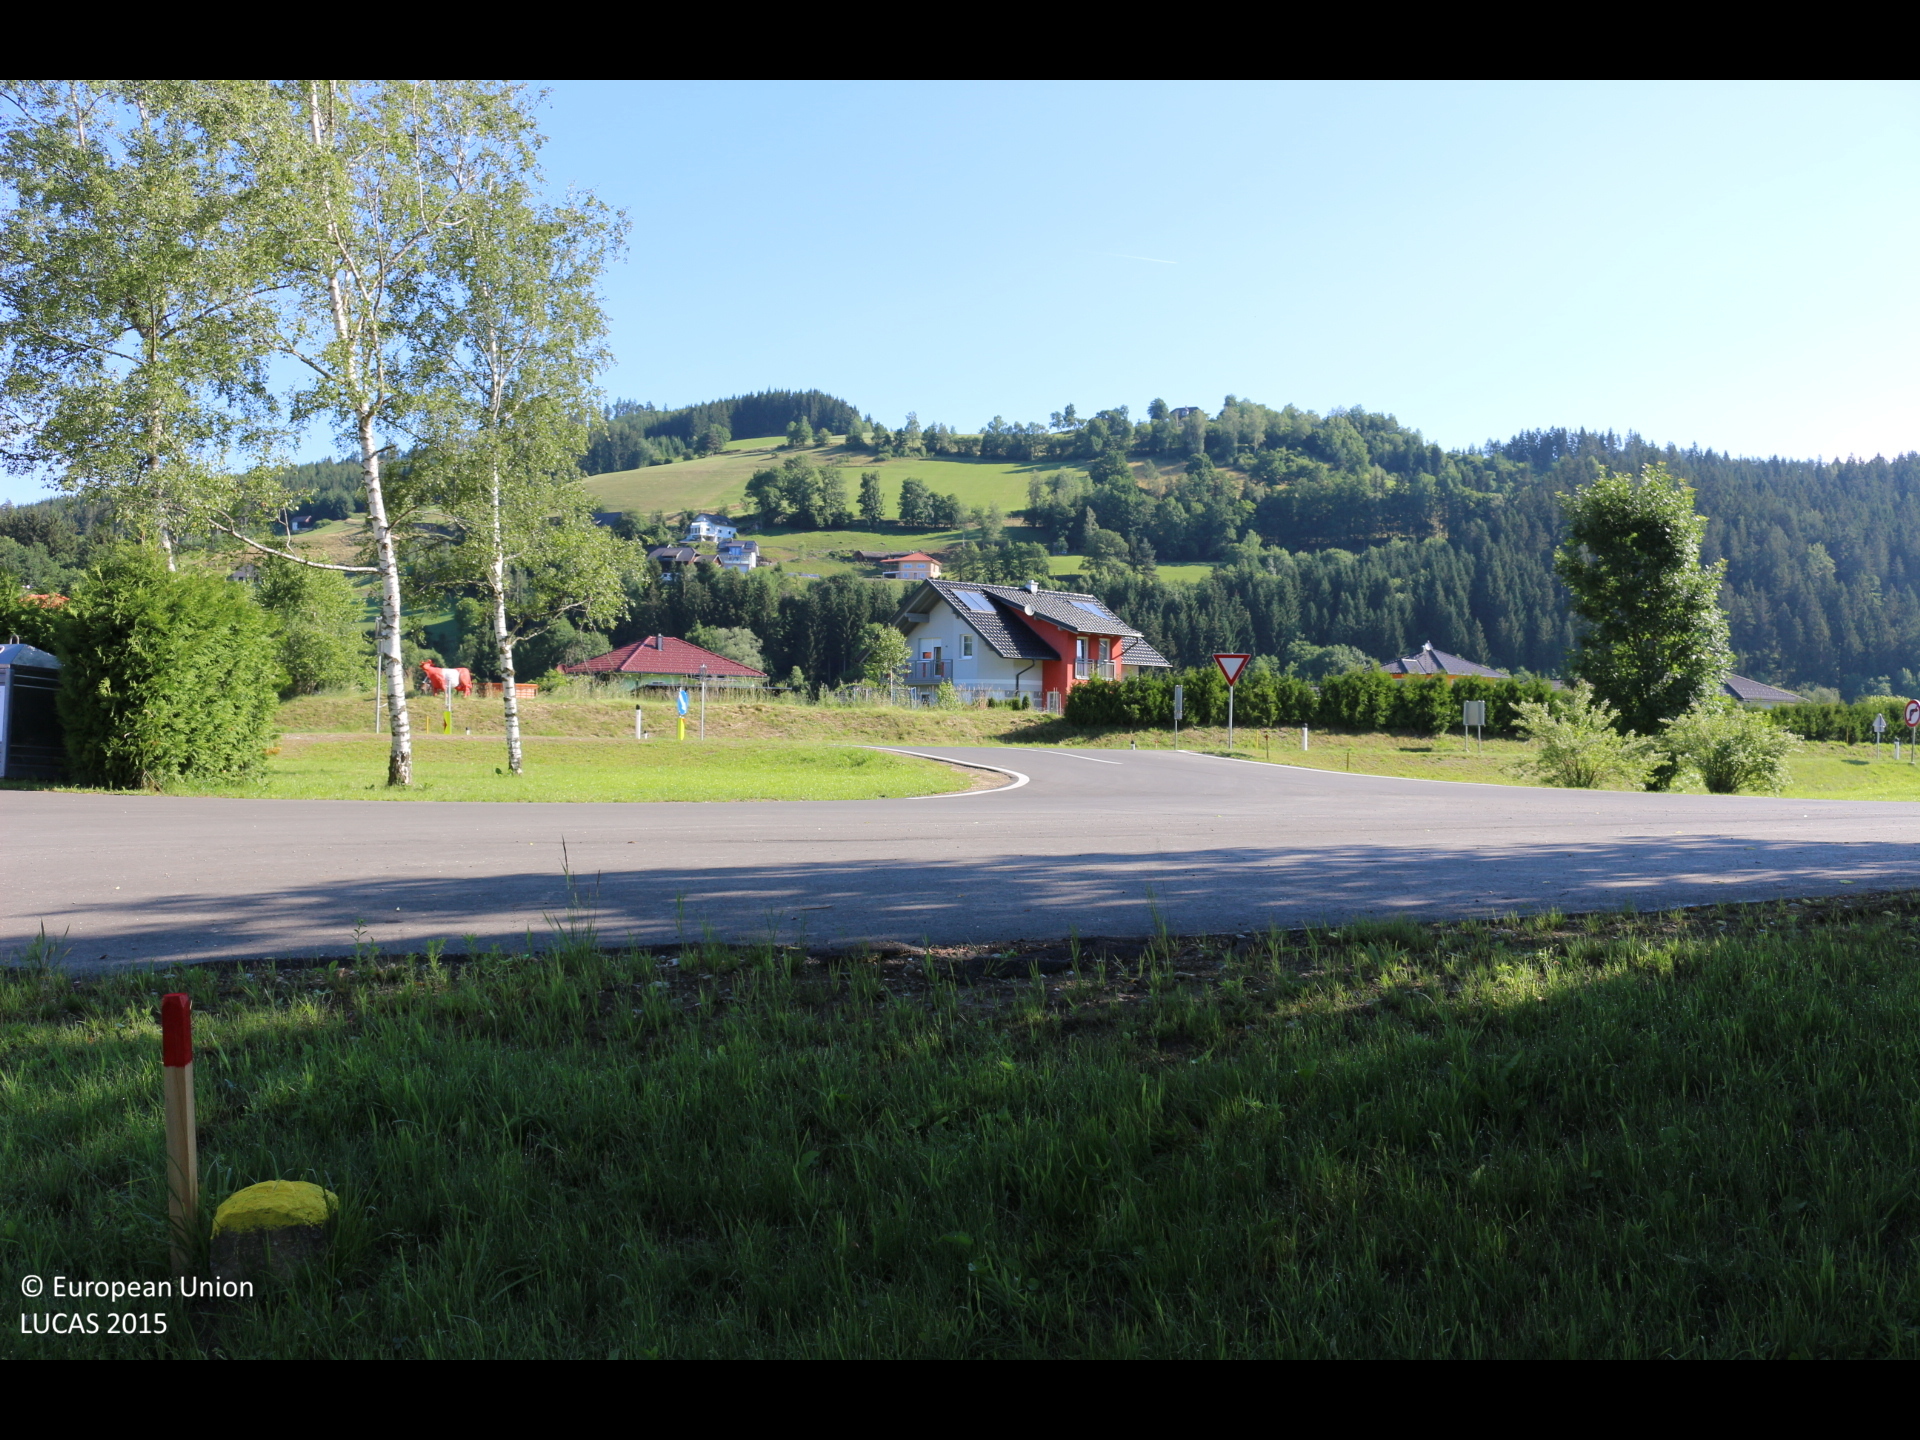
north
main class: Grassland
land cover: Grassland with sparse tree/shrub cover
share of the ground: > 75 %
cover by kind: herbaceous plants 95 %, broadleaved forest trees 5 %
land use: Agriculture (excluding fallow land and kitchen gardens)
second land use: Residential
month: June
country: AT
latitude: 46.8625
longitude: 14.2348
